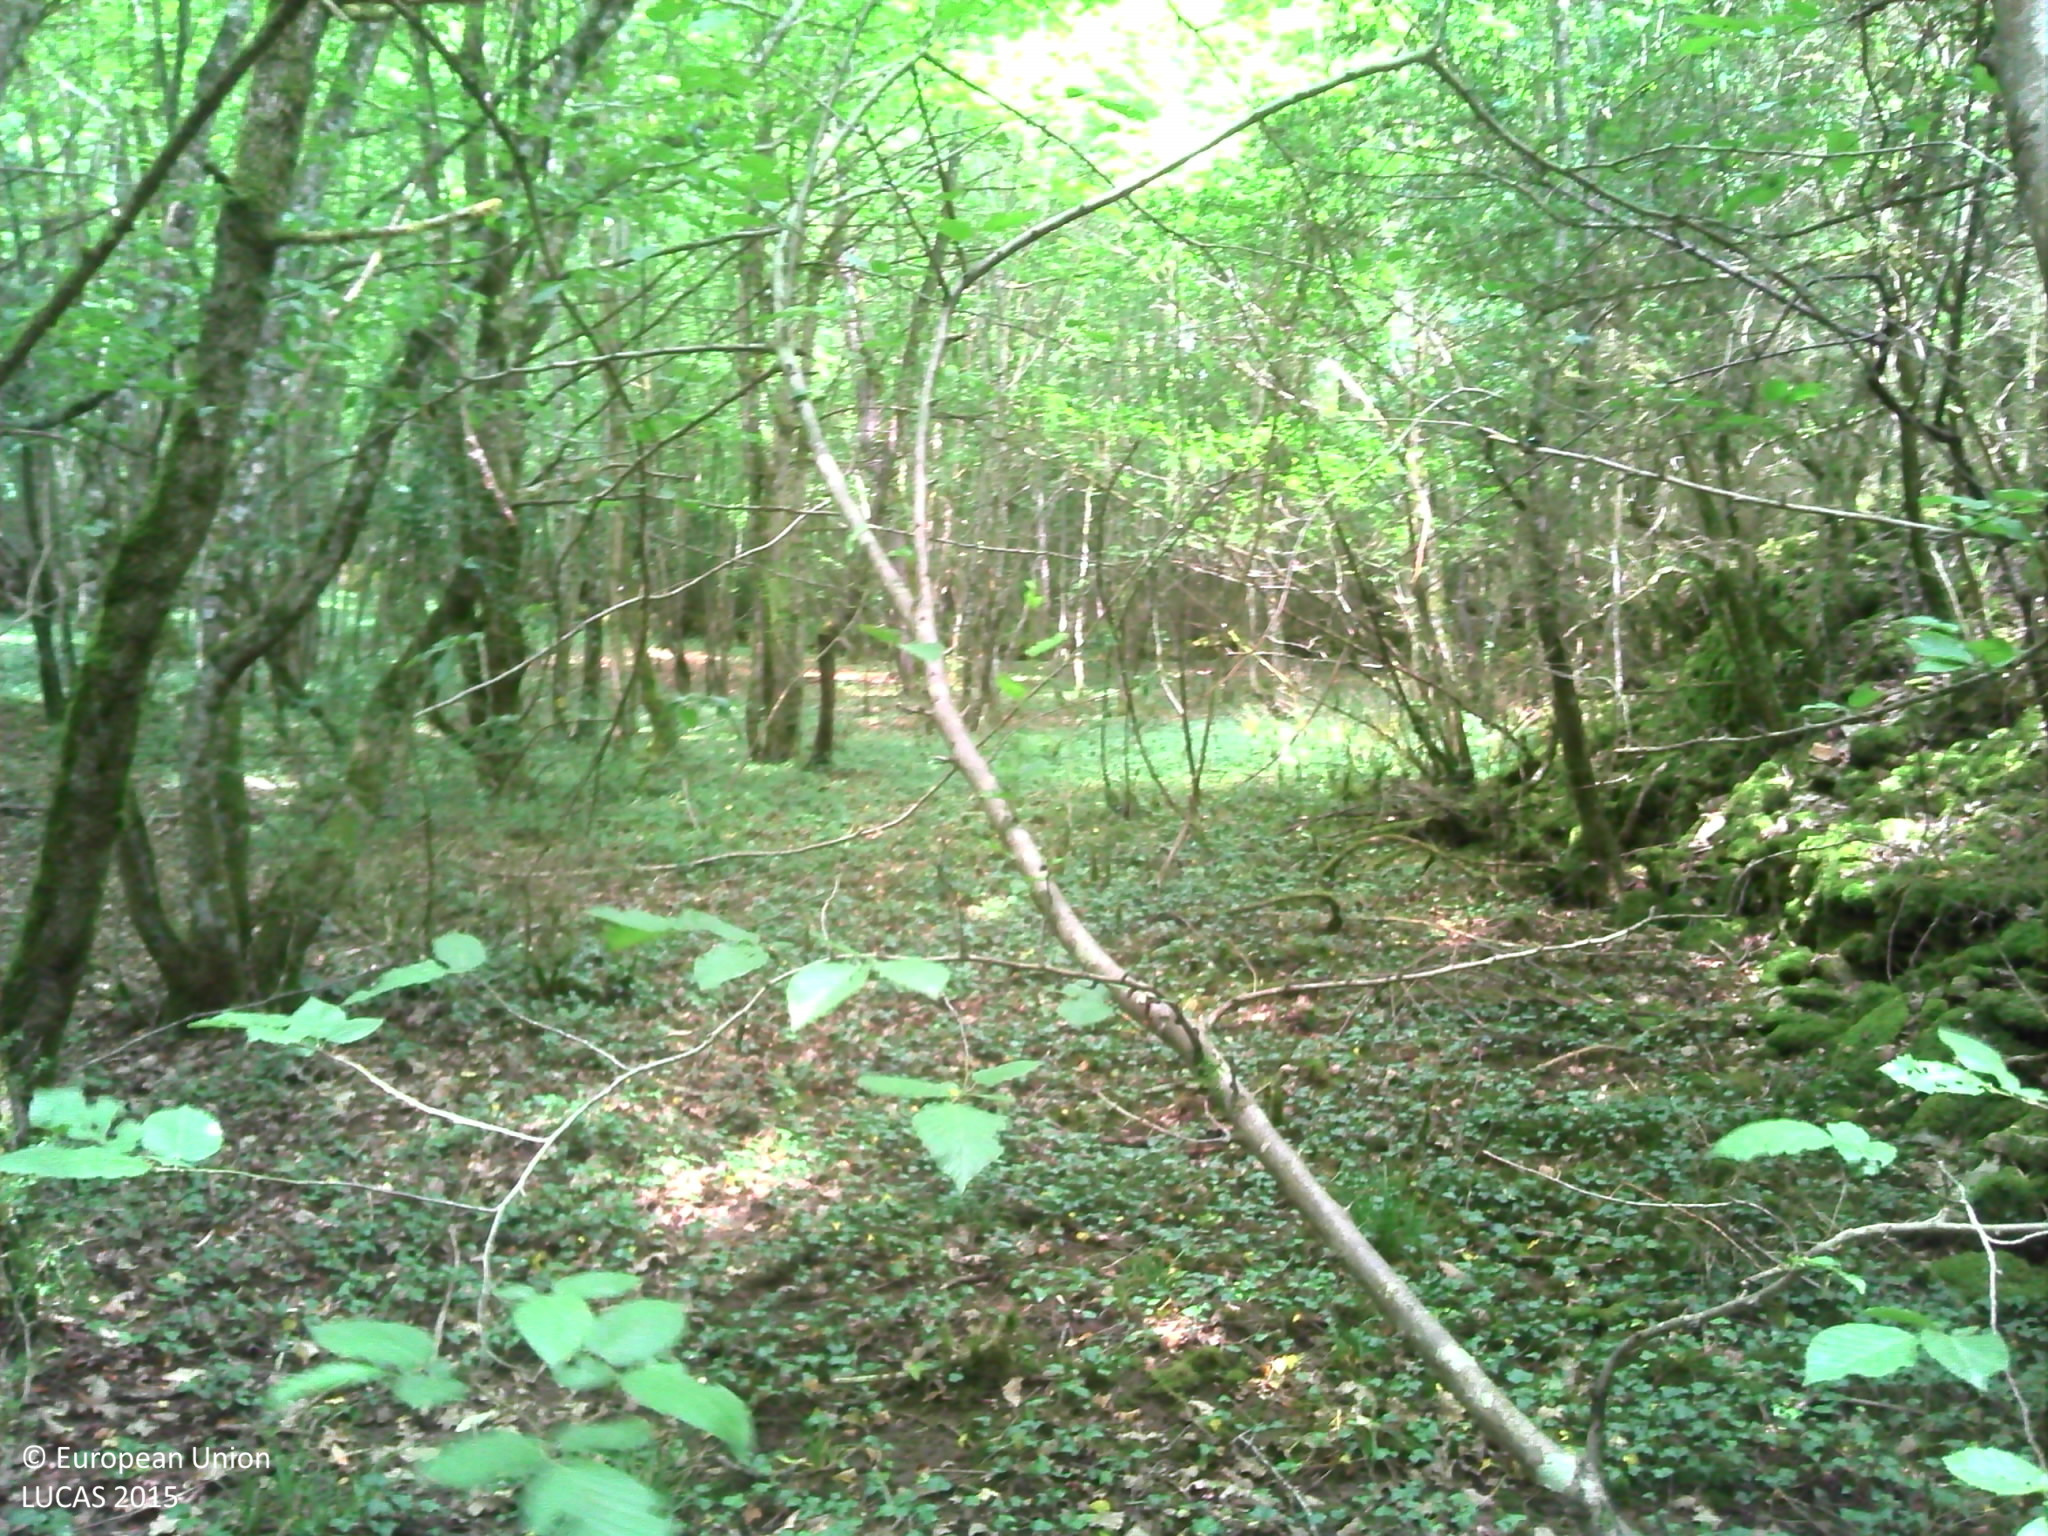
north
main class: Woodland
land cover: Broadleaved woodland
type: mesophytic deciduous forest
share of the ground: > 75 %
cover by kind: broadleaved forest trees 60 %, herbaceous plants 35 %, lichens and mosses 5 %
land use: Forestry
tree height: > 5 m
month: June
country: FR
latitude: 46.5687
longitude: 4.8222
